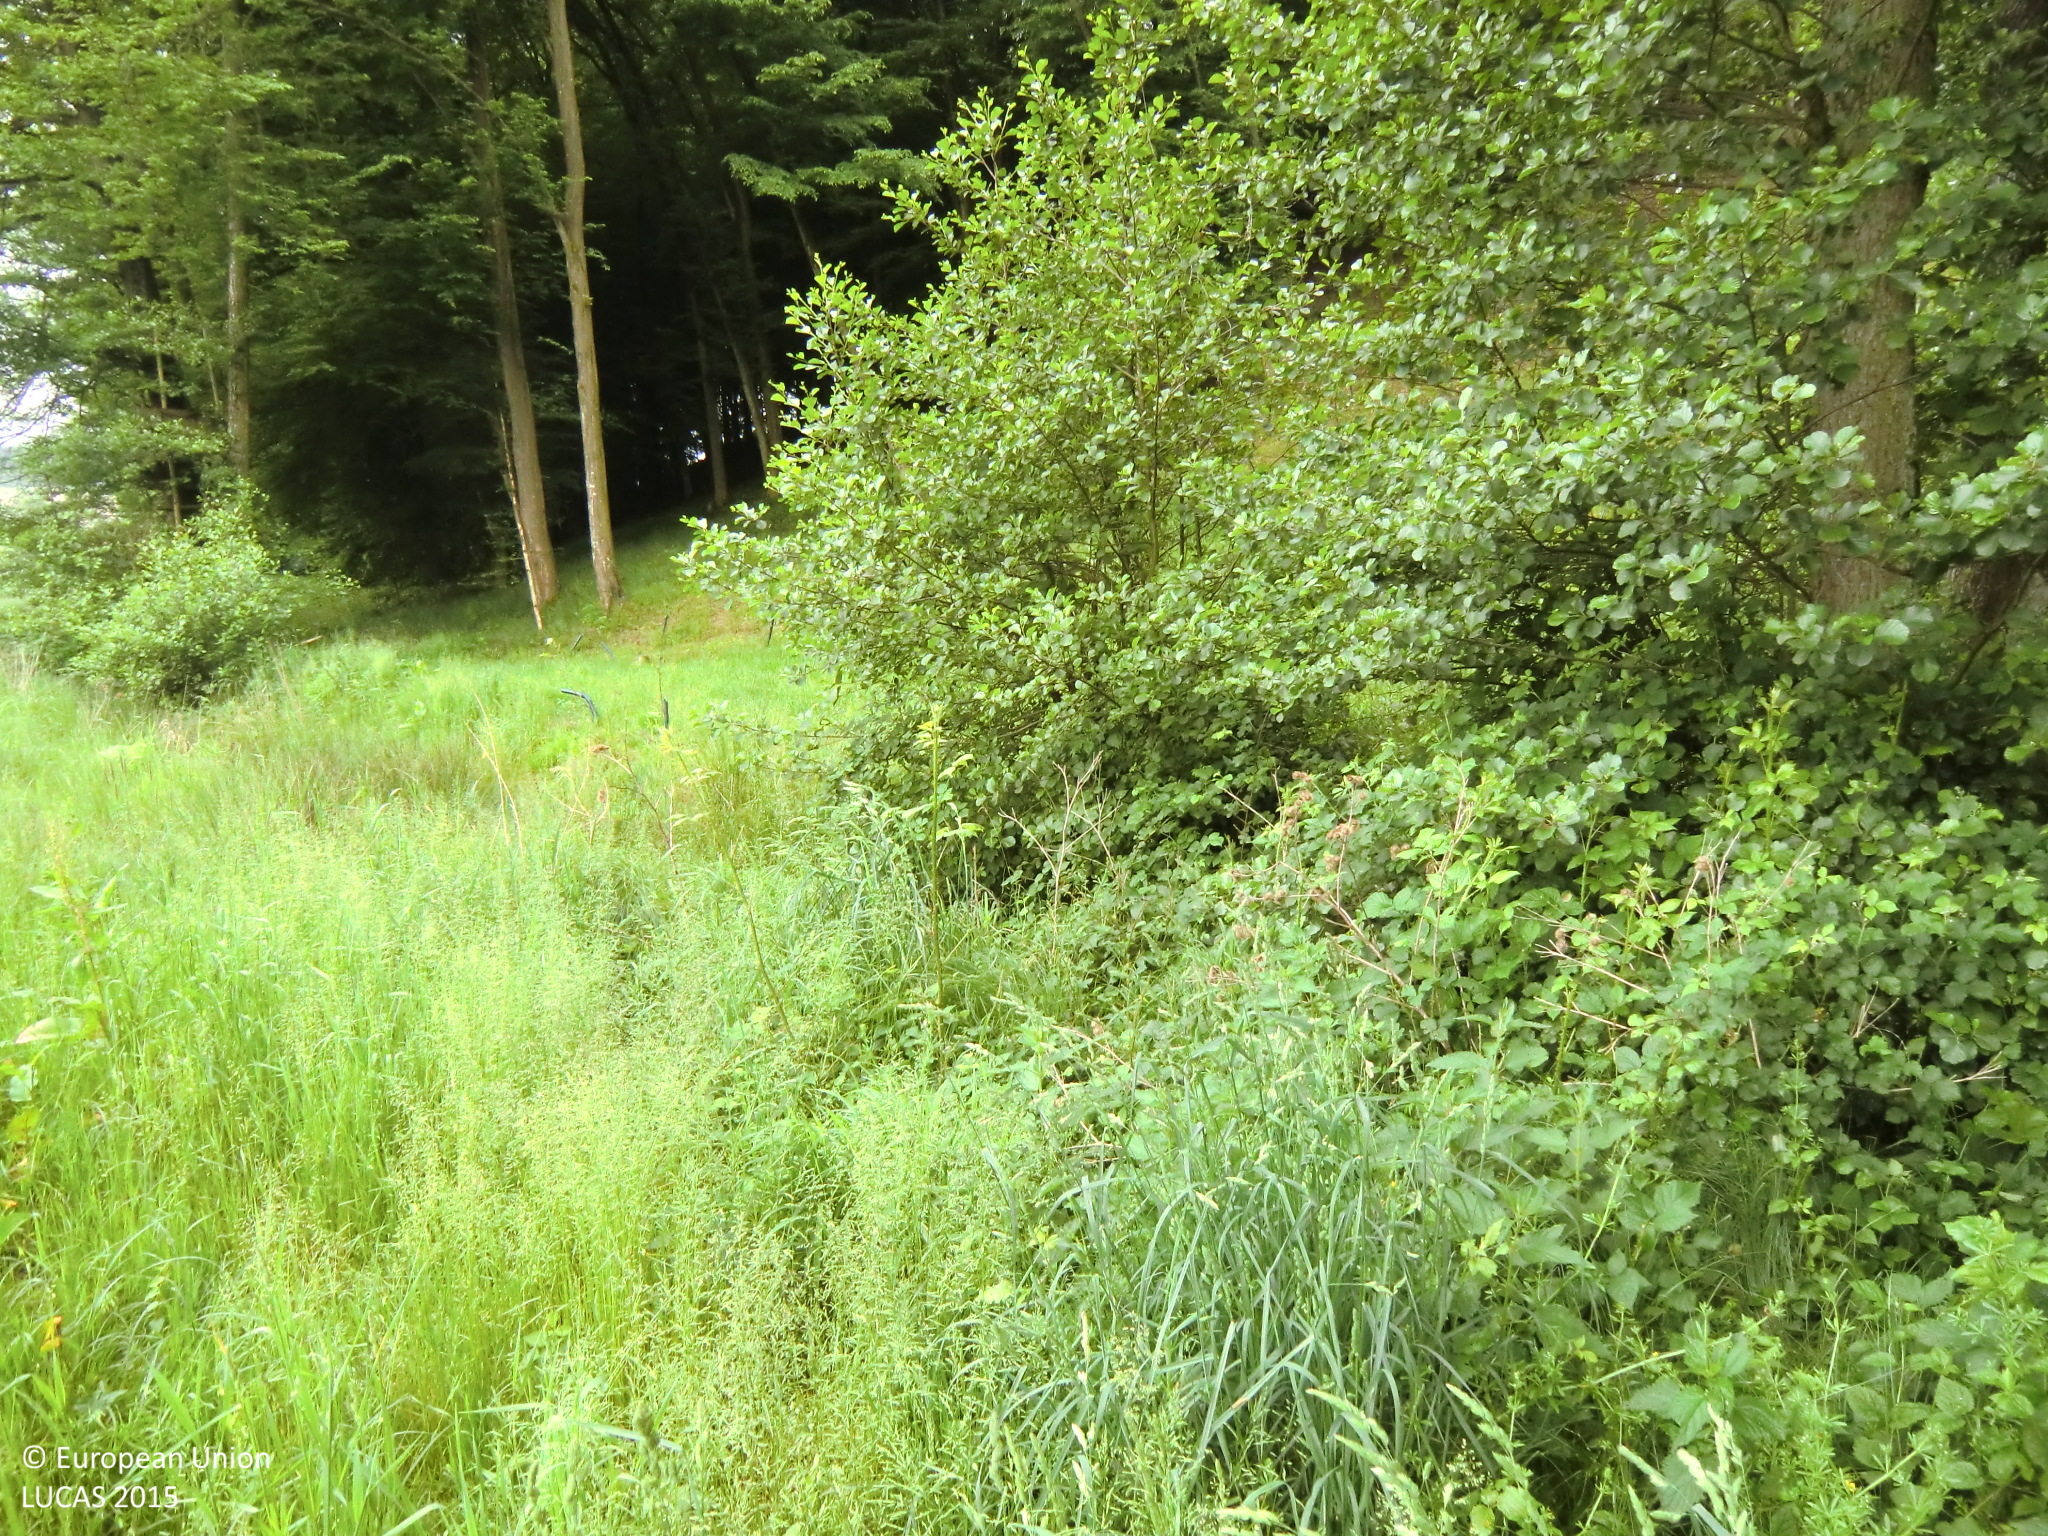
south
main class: Grassland
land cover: Grassland without tree/shrub cover
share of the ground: > 75 %
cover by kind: herbaceous plants 100 %
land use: Agriculture (excluding fallow land and kitchen gardens)
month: May
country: AT
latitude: 48.1637
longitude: 15.3934
